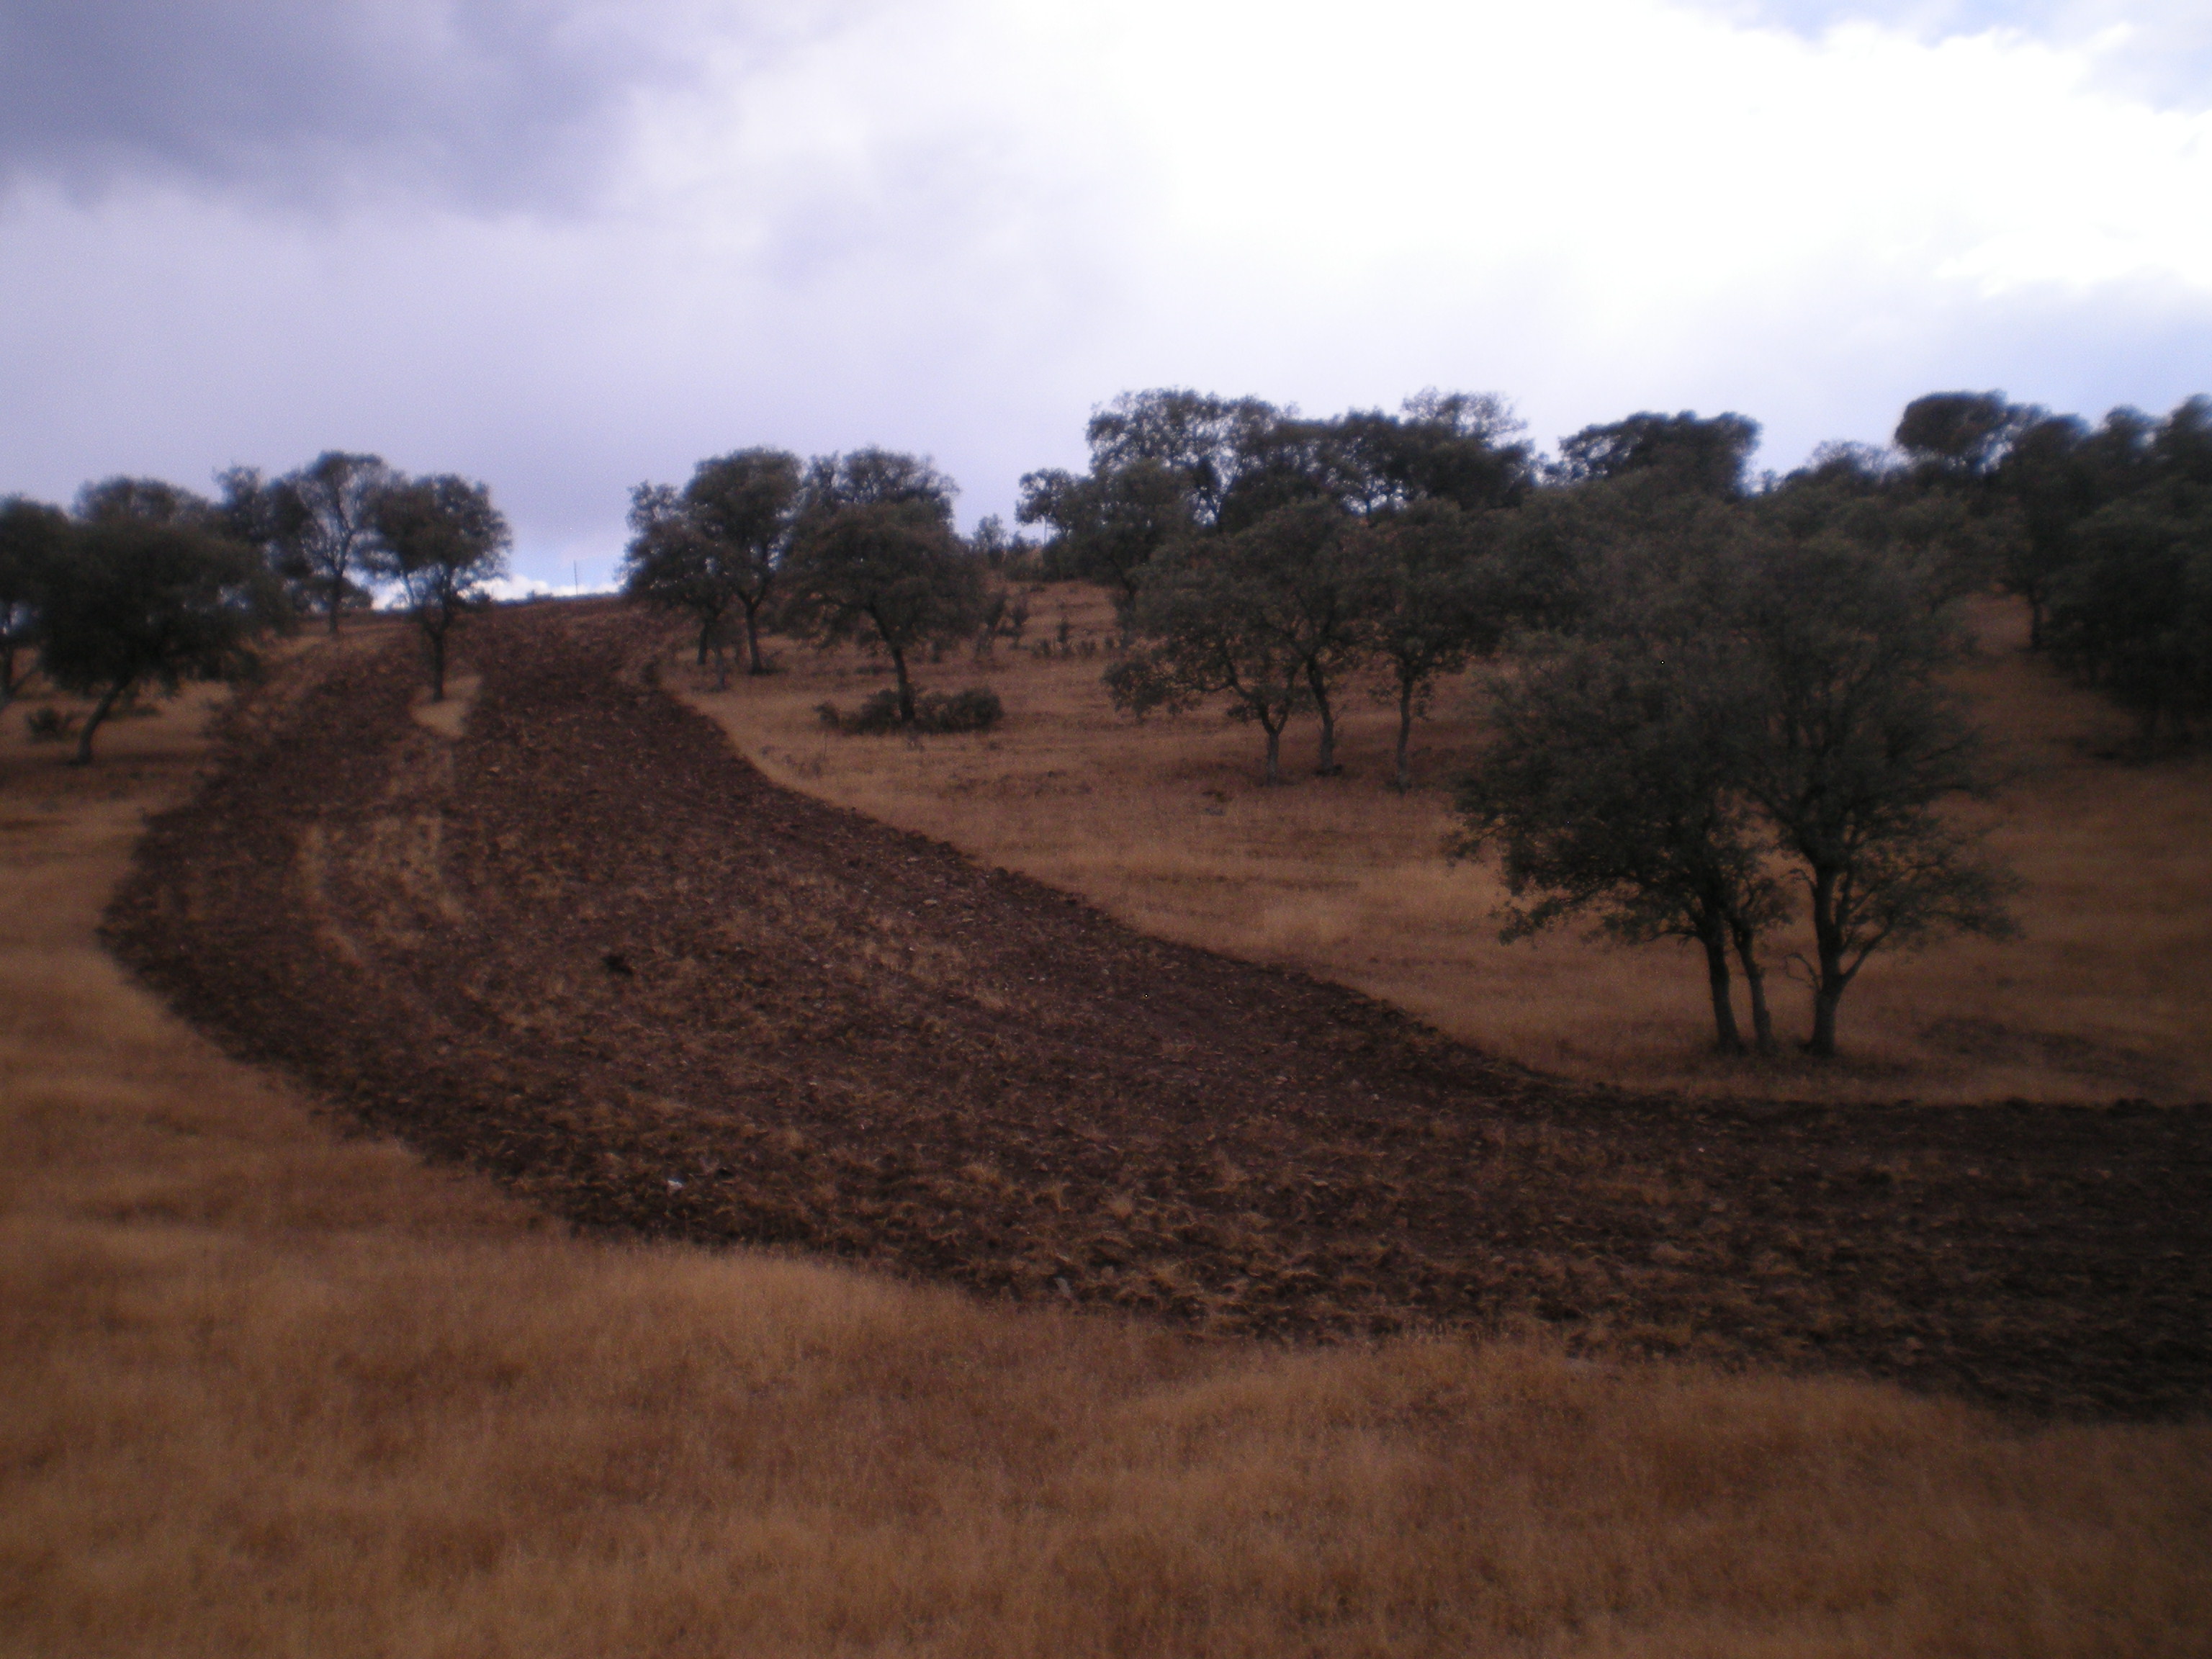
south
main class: Grassland
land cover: Grassland with sparse tree/shrub cover
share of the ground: 10 - 25 %
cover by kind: unconsolidated bare surface 80 %, herbaceous plants 15 %, broadleaved forest trees 5 %
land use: Agriculture (excluding fallow land and kitchen gardens)
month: June
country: ES
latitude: 38.4519
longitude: -3.3557
